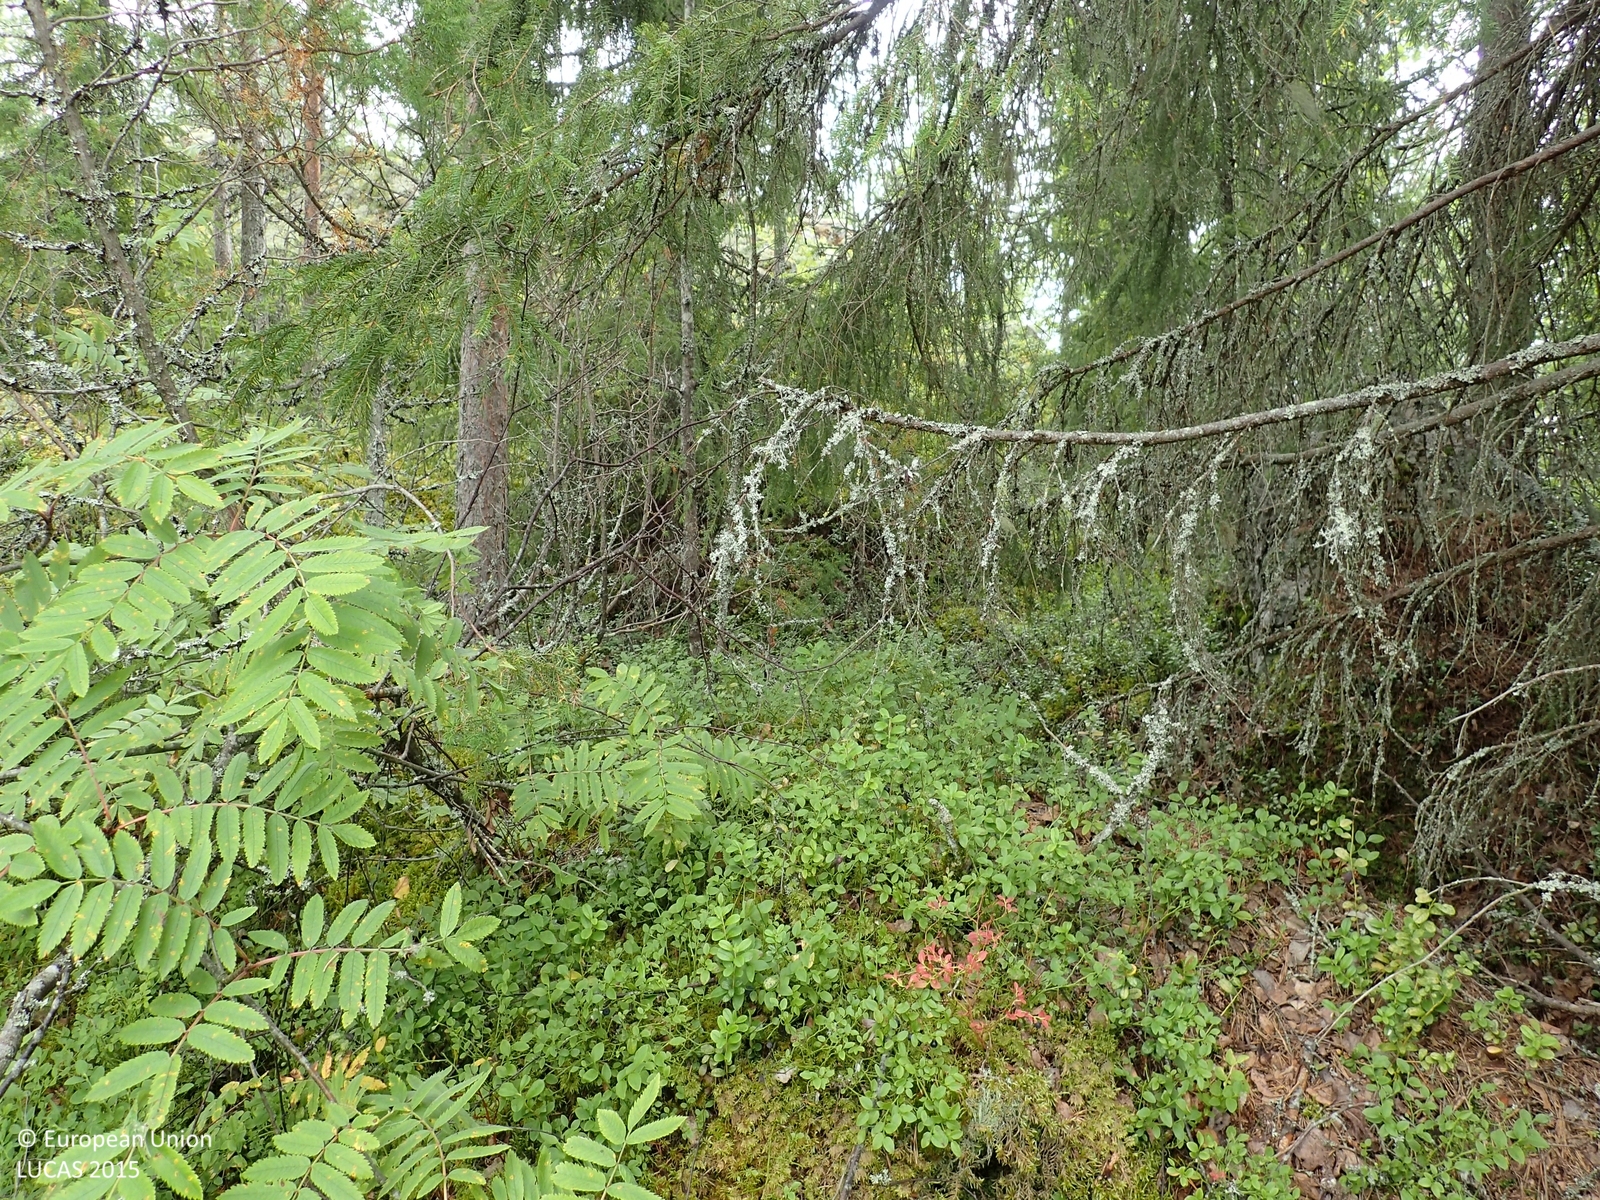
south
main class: Woodland
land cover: Other mixed woodland
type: boreal forest
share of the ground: > 75 %
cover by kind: coniferous forest trees 55 %, broadleaved forest trees 20 %, shrubs 20 %, lichens and mosses 5 %
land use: Forestry
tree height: > 5 m
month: August
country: FI
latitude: 62.7959
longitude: 21.9080
